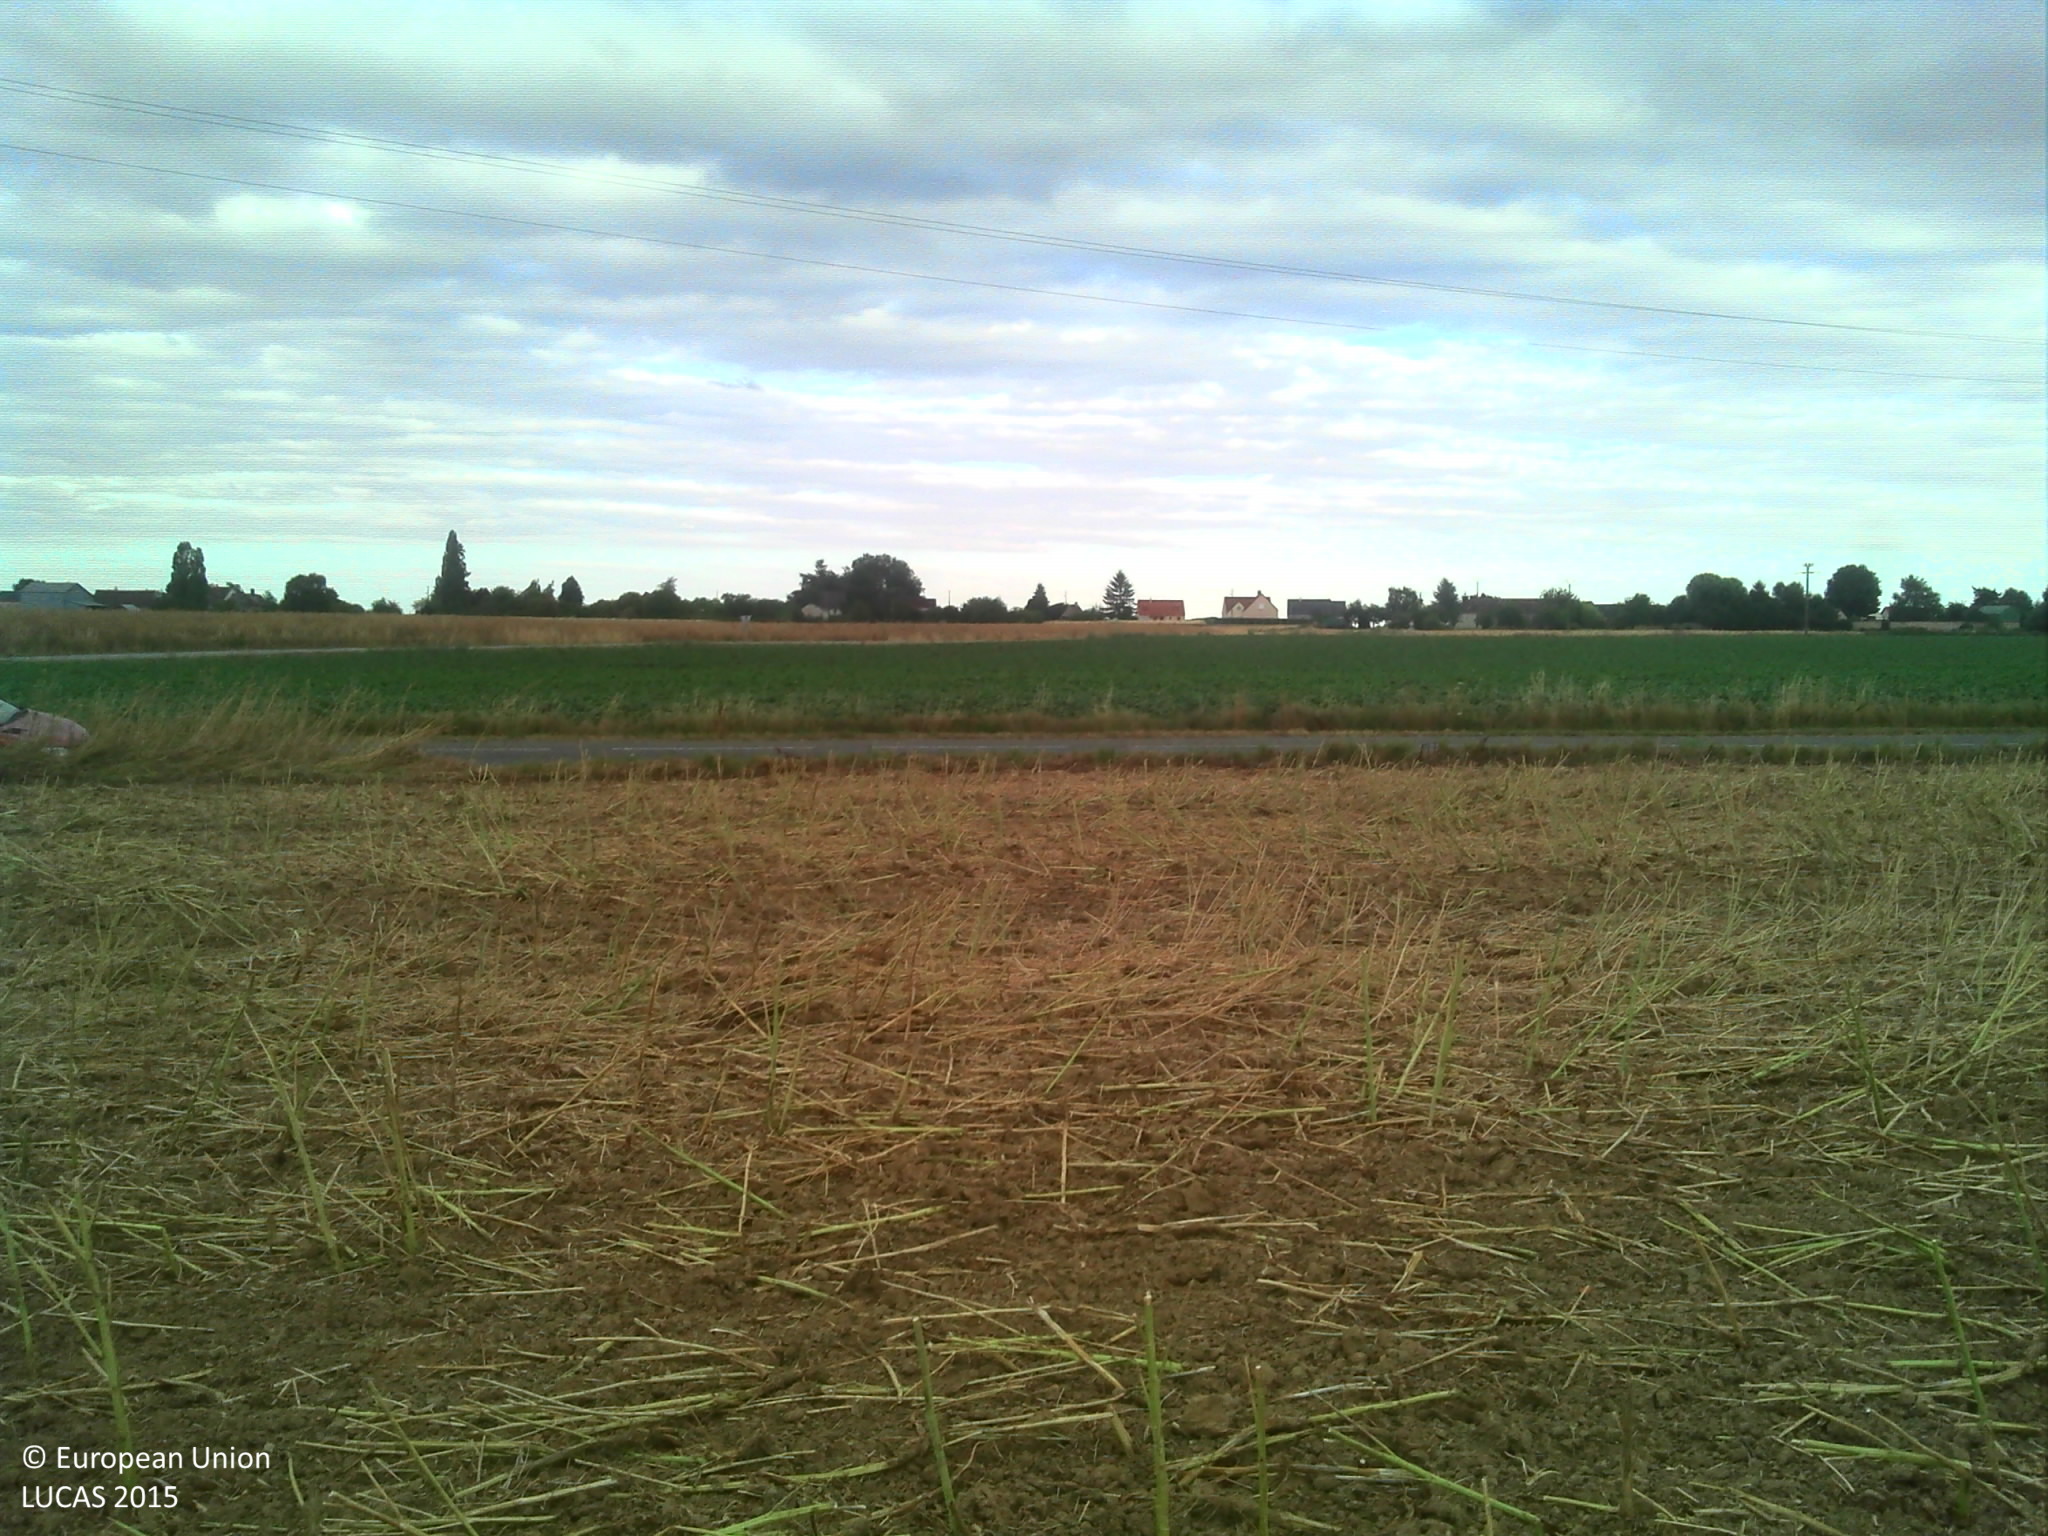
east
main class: Cropland
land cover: Rape and turnip rape
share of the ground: > 75 %
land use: Agriculture (excluding fallow land and kitchen gardens)
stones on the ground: < 10 %
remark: Harvested field
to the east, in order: Rape and turnip rape; Ditches and canals; Grass margins; Paved roads, cycling and walking lanes; Grass margins; Ditches and canals; Other fresh vegetables; Electric lines; Other fresh vegetables; Ditches and canals; Grass margins; Paved roads, cycling and walking lanes; Grass margins; Rape and turnip rape
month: July
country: FR
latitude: 48.4350
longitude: 1.2363
